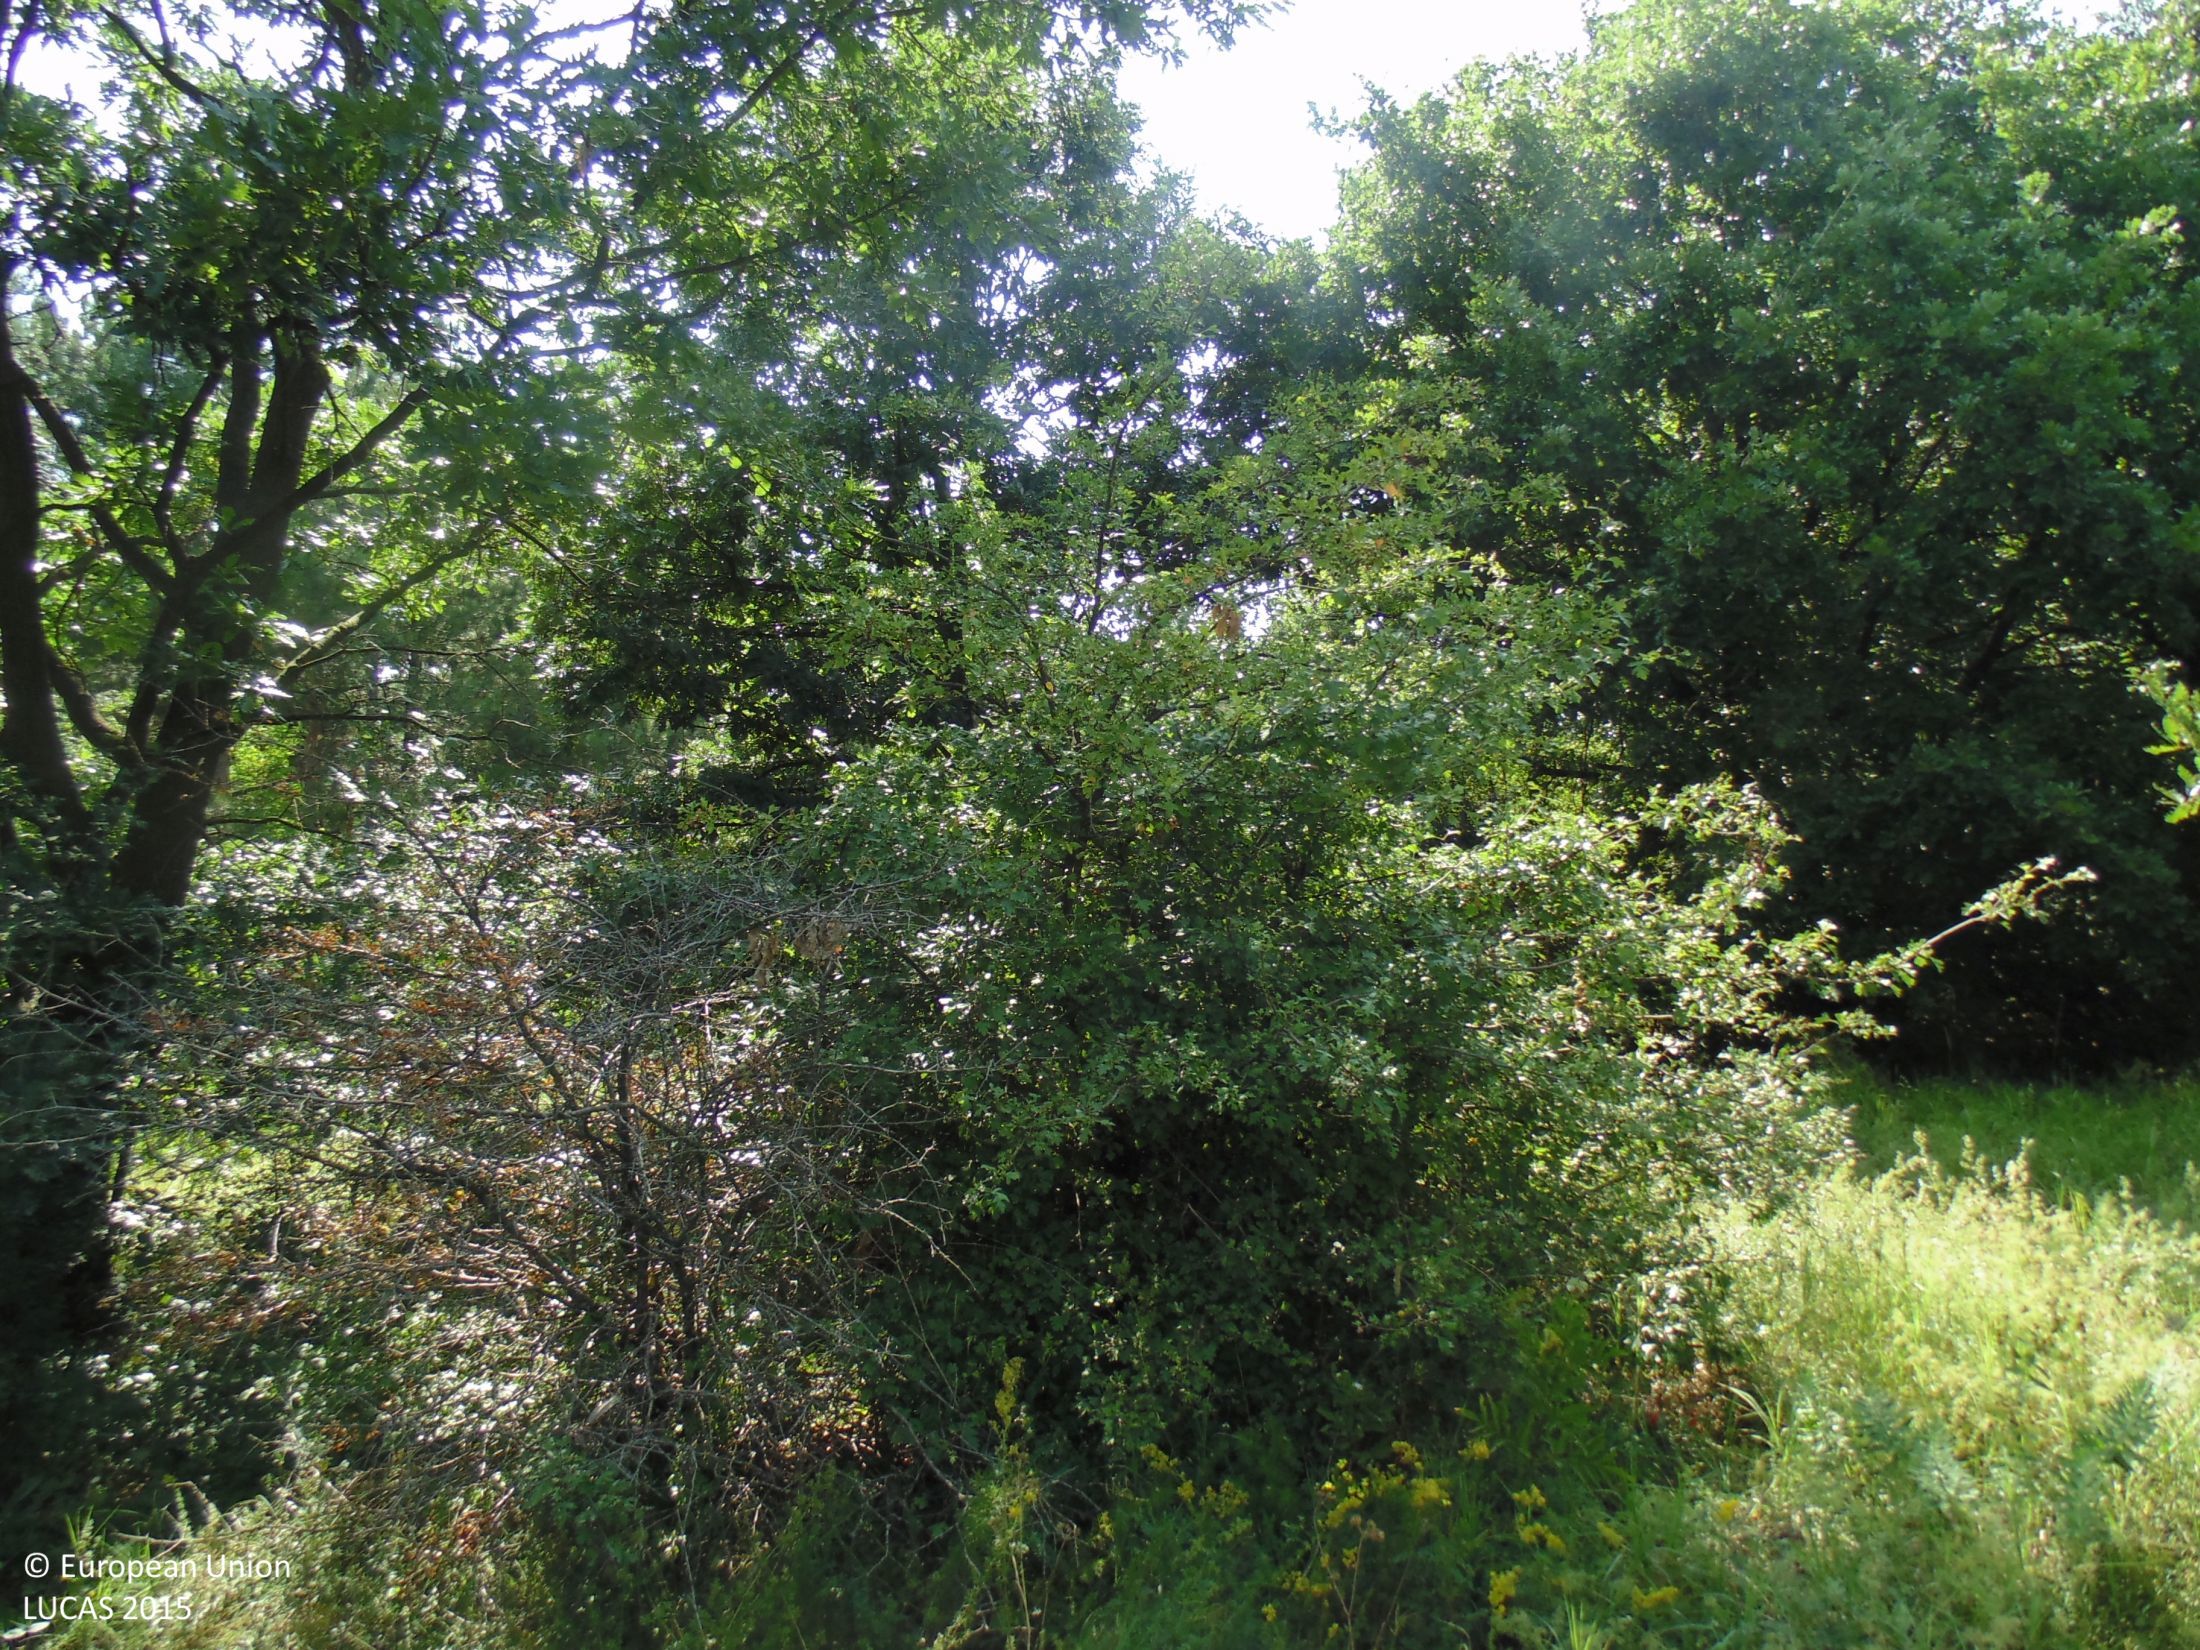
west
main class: Woodland
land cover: Broadleaved woodland
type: mesophytic deciduous forest
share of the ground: > 75 %
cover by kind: broadleaved forest trees 75 %, herbaceous plants 20 %, shrubs 5 %
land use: Forestry
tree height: > 5 m
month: July
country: BG
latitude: 43.5980
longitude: 27.5378
